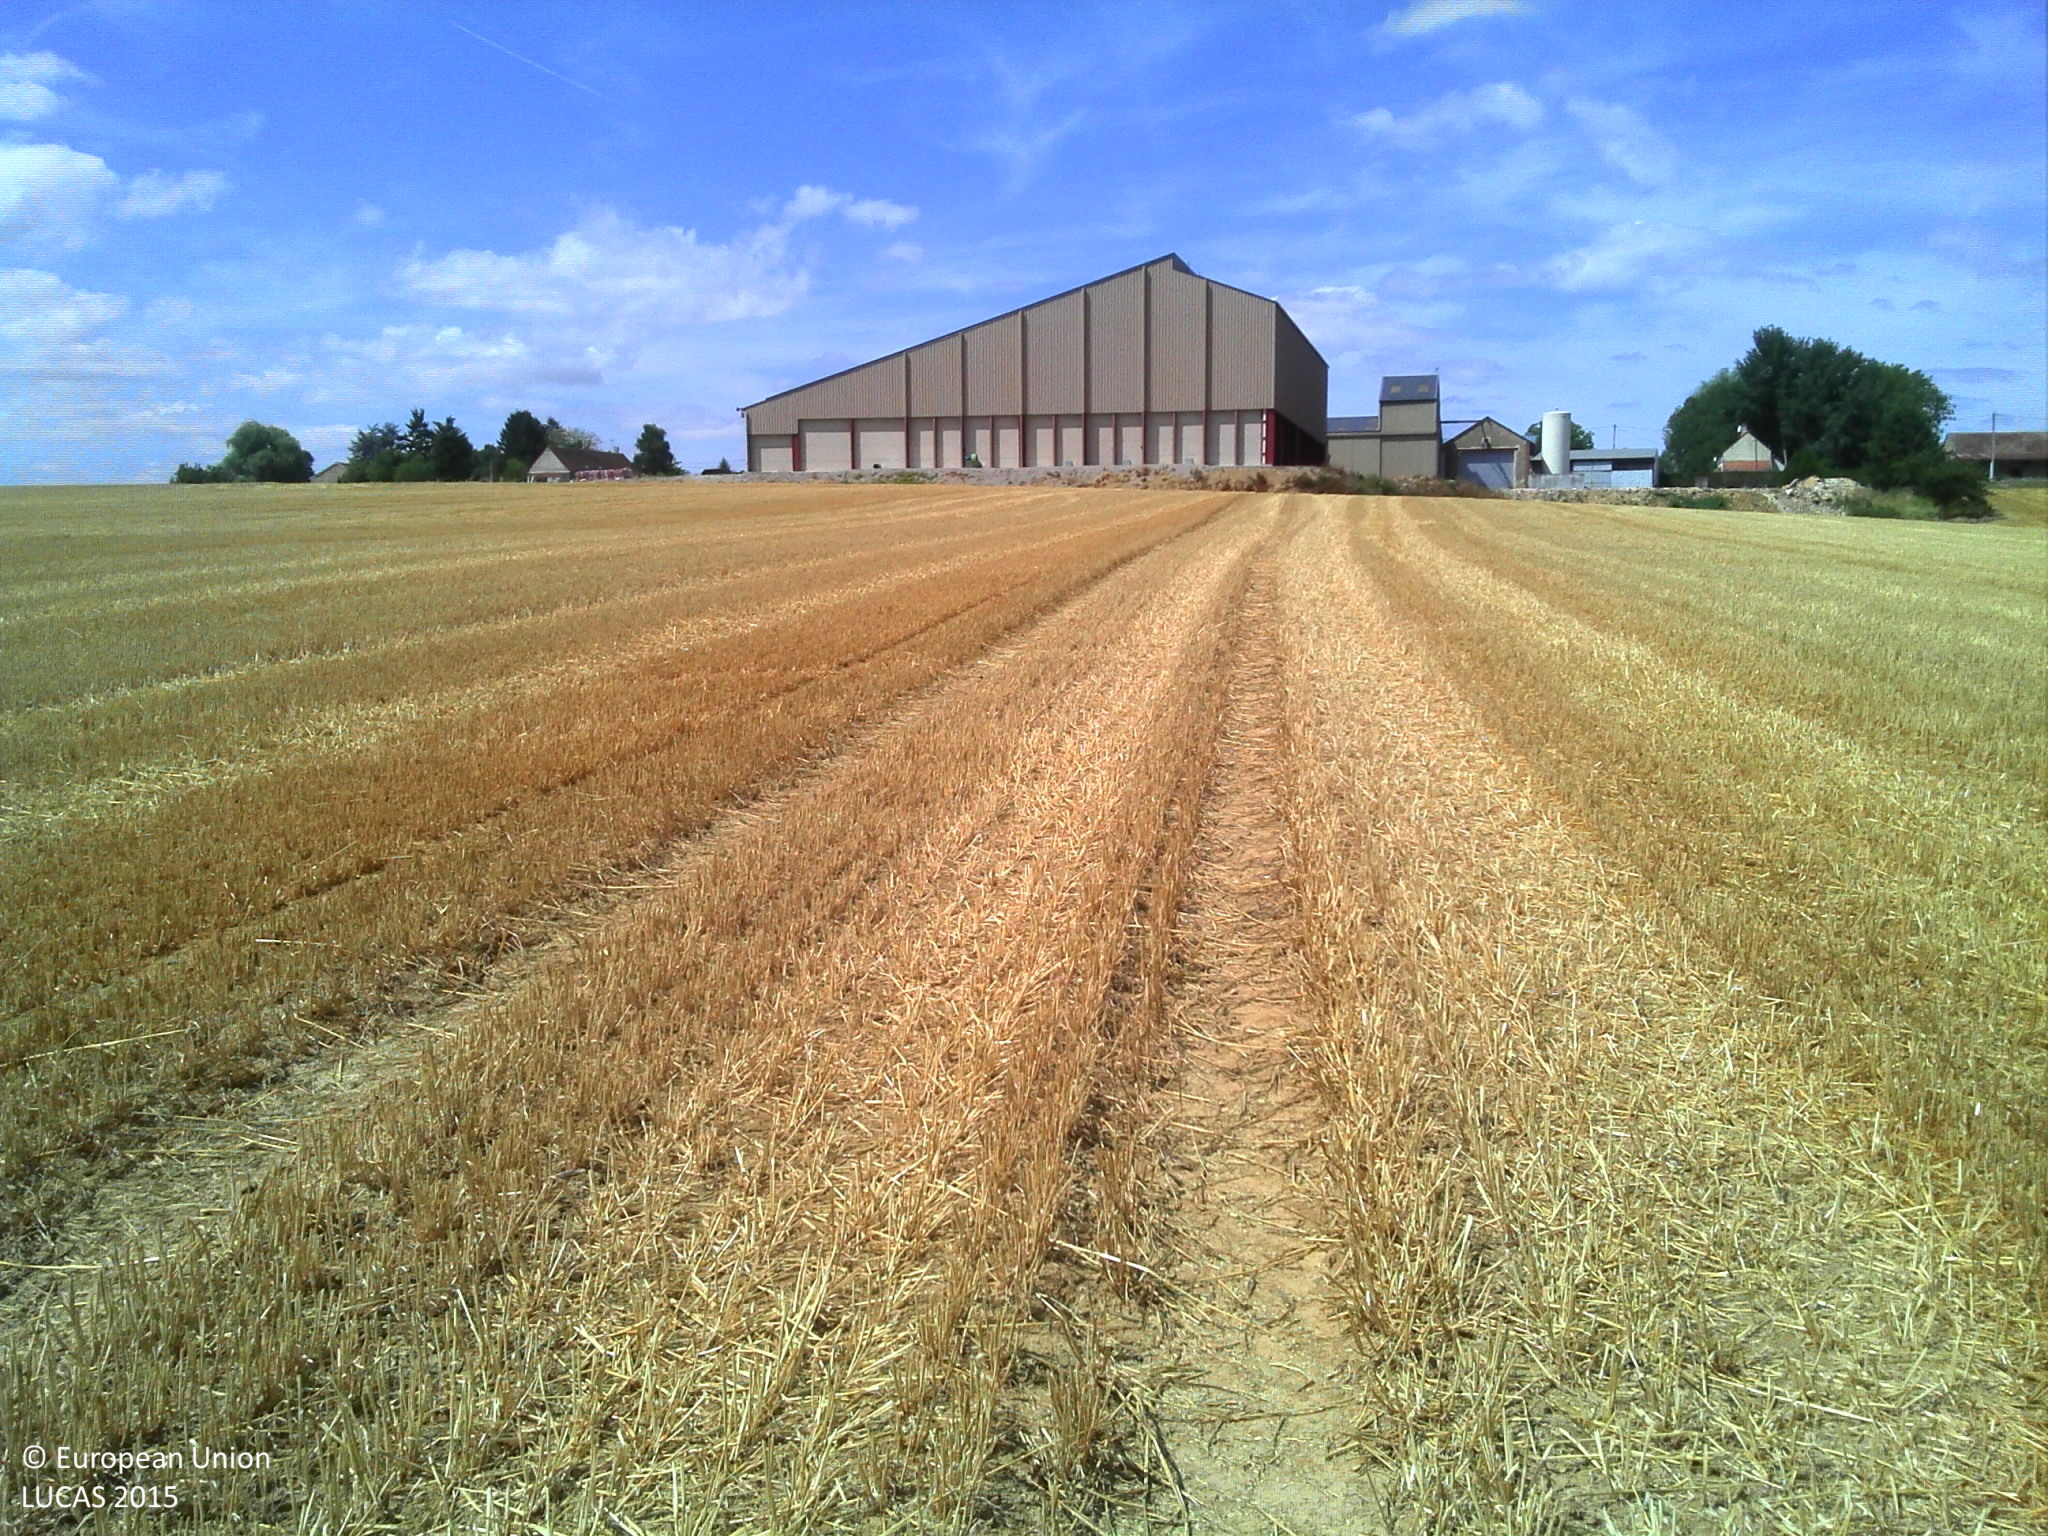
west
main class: Cropland
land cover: Durum wheat
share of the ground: 10 - 25 %
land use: Agriculture (excluding fallow land and kitchen gardens)
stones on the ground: 10 - 25 %
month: August
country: FR
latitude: 48.7134
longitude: 3.4290
